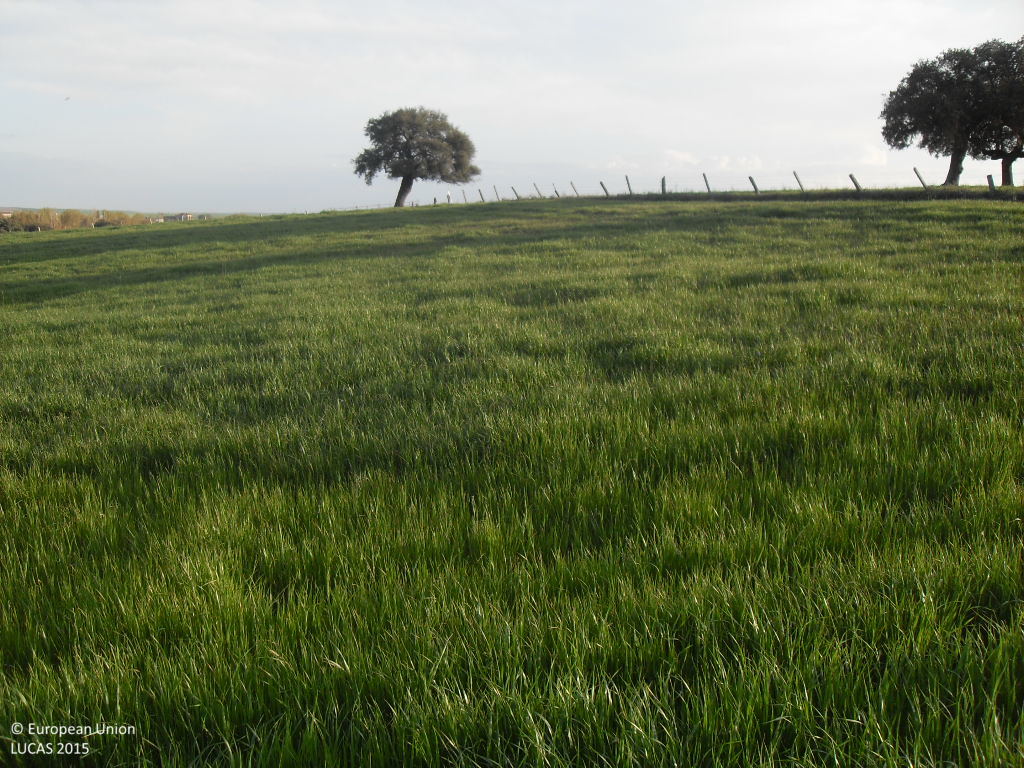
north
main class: Cropland
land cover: Barley
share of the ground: > 75 %
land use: Agriculture (excluding fallow land and kitchen gardens)
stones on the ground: < 10 %
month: April
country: ES
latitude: 40.7338
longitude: -5.2824
